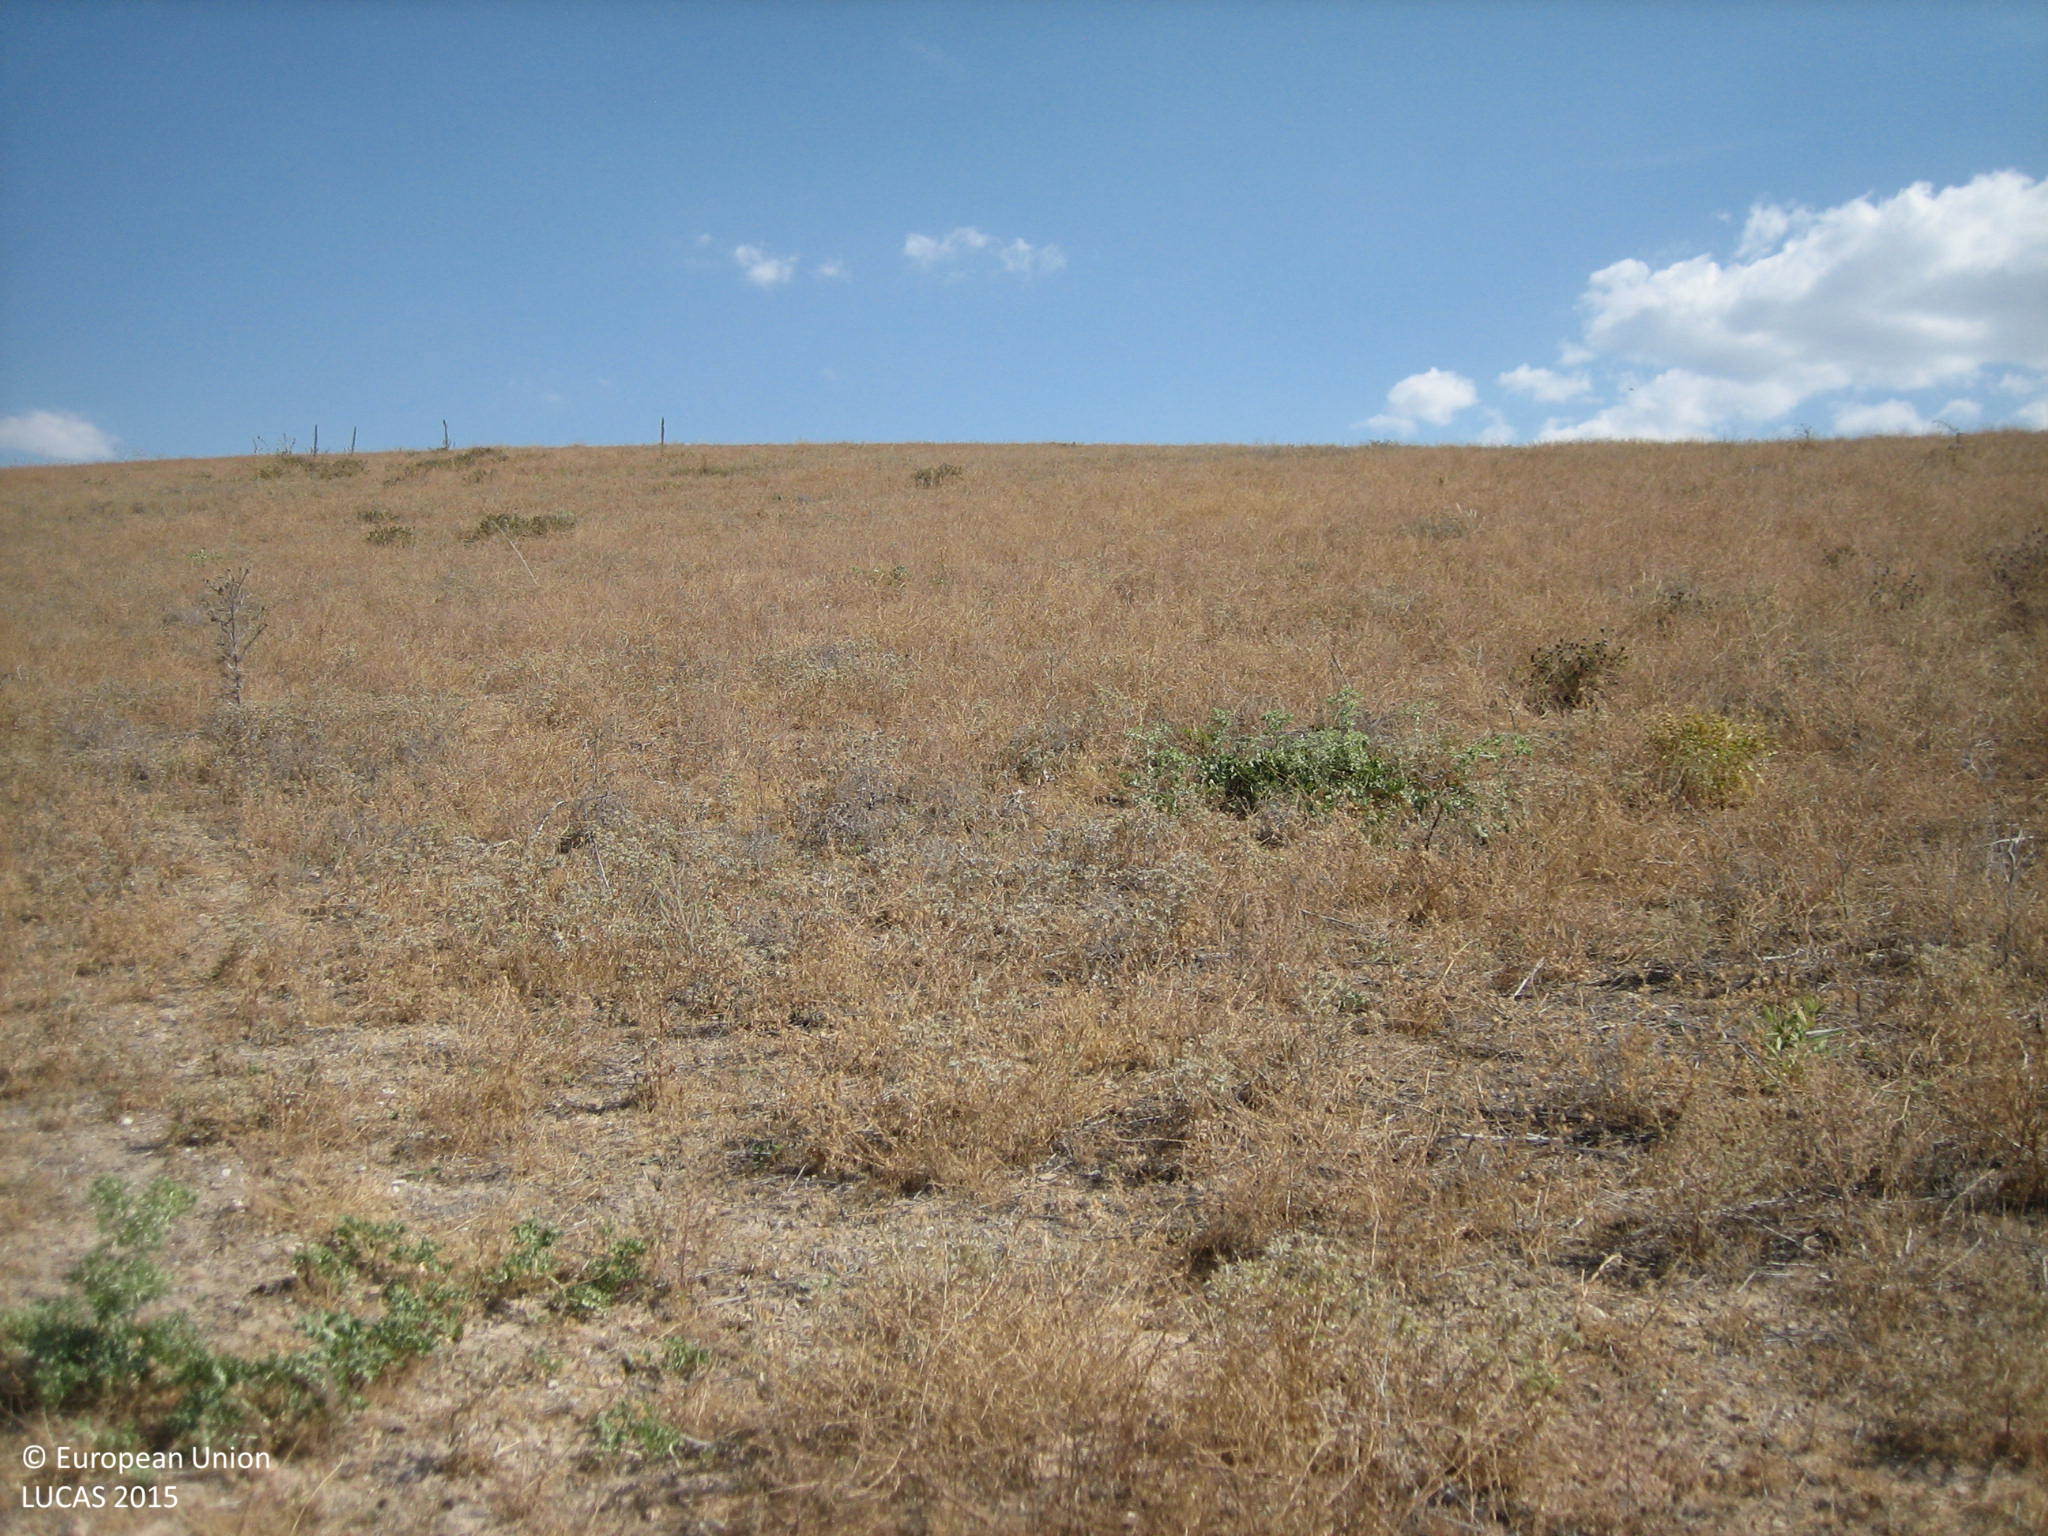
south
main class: Grassland
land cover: Grassland without tree/shrub cover
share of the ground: > 75 %
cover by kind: herbaceous plants 100 %
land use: Abandoned areas
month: June
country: ES
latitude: 37.8223
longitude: -3.7817
